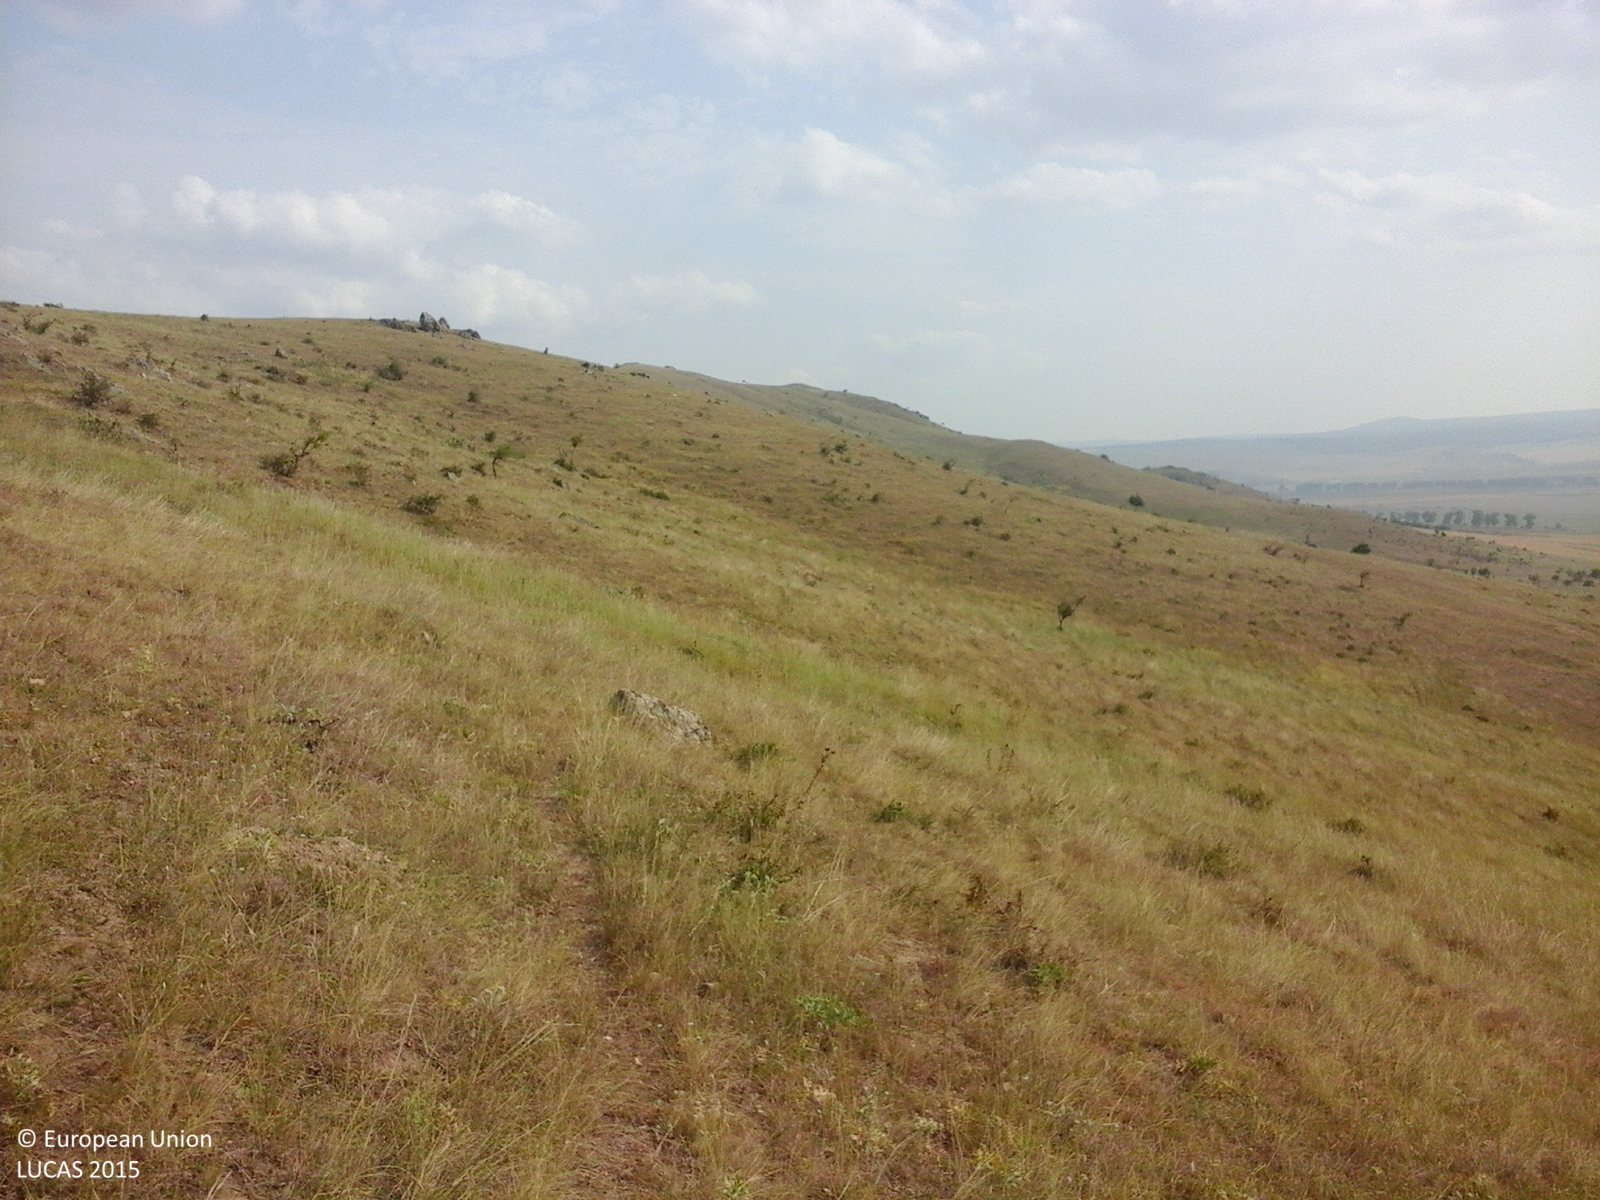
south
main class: Grassland
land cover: Grassland without tree/shrub cover
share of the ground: > 75 %
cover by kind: herbaceous plants 100 %
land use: Agriculture (excluding fallow land and kitchen gardens)
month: July
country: RO
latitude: 45.0772
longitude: 28.4586
